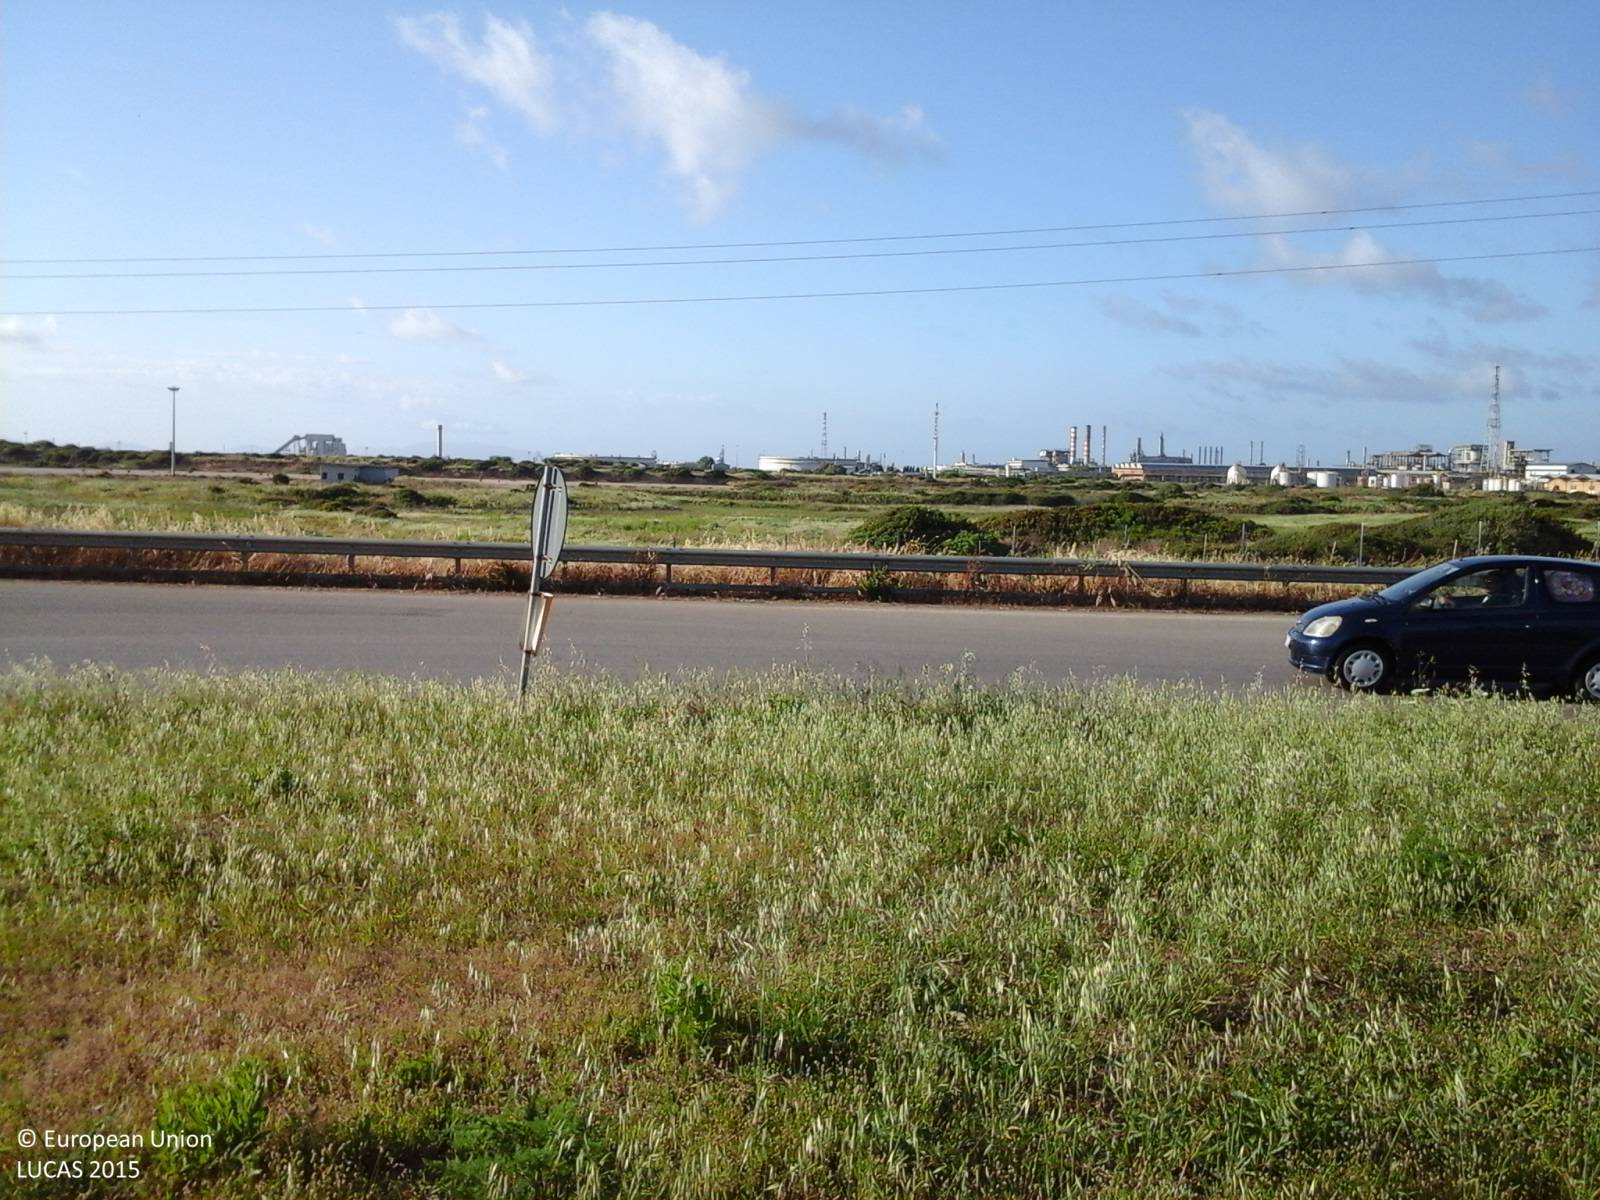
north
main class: Grassland
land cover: Grassland without tree/shrub cover
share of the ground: > 75 %
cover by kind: herbaceous plants 100 %
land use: Road transport
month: May
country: IT
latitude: 40.8147
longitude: 8.3598
